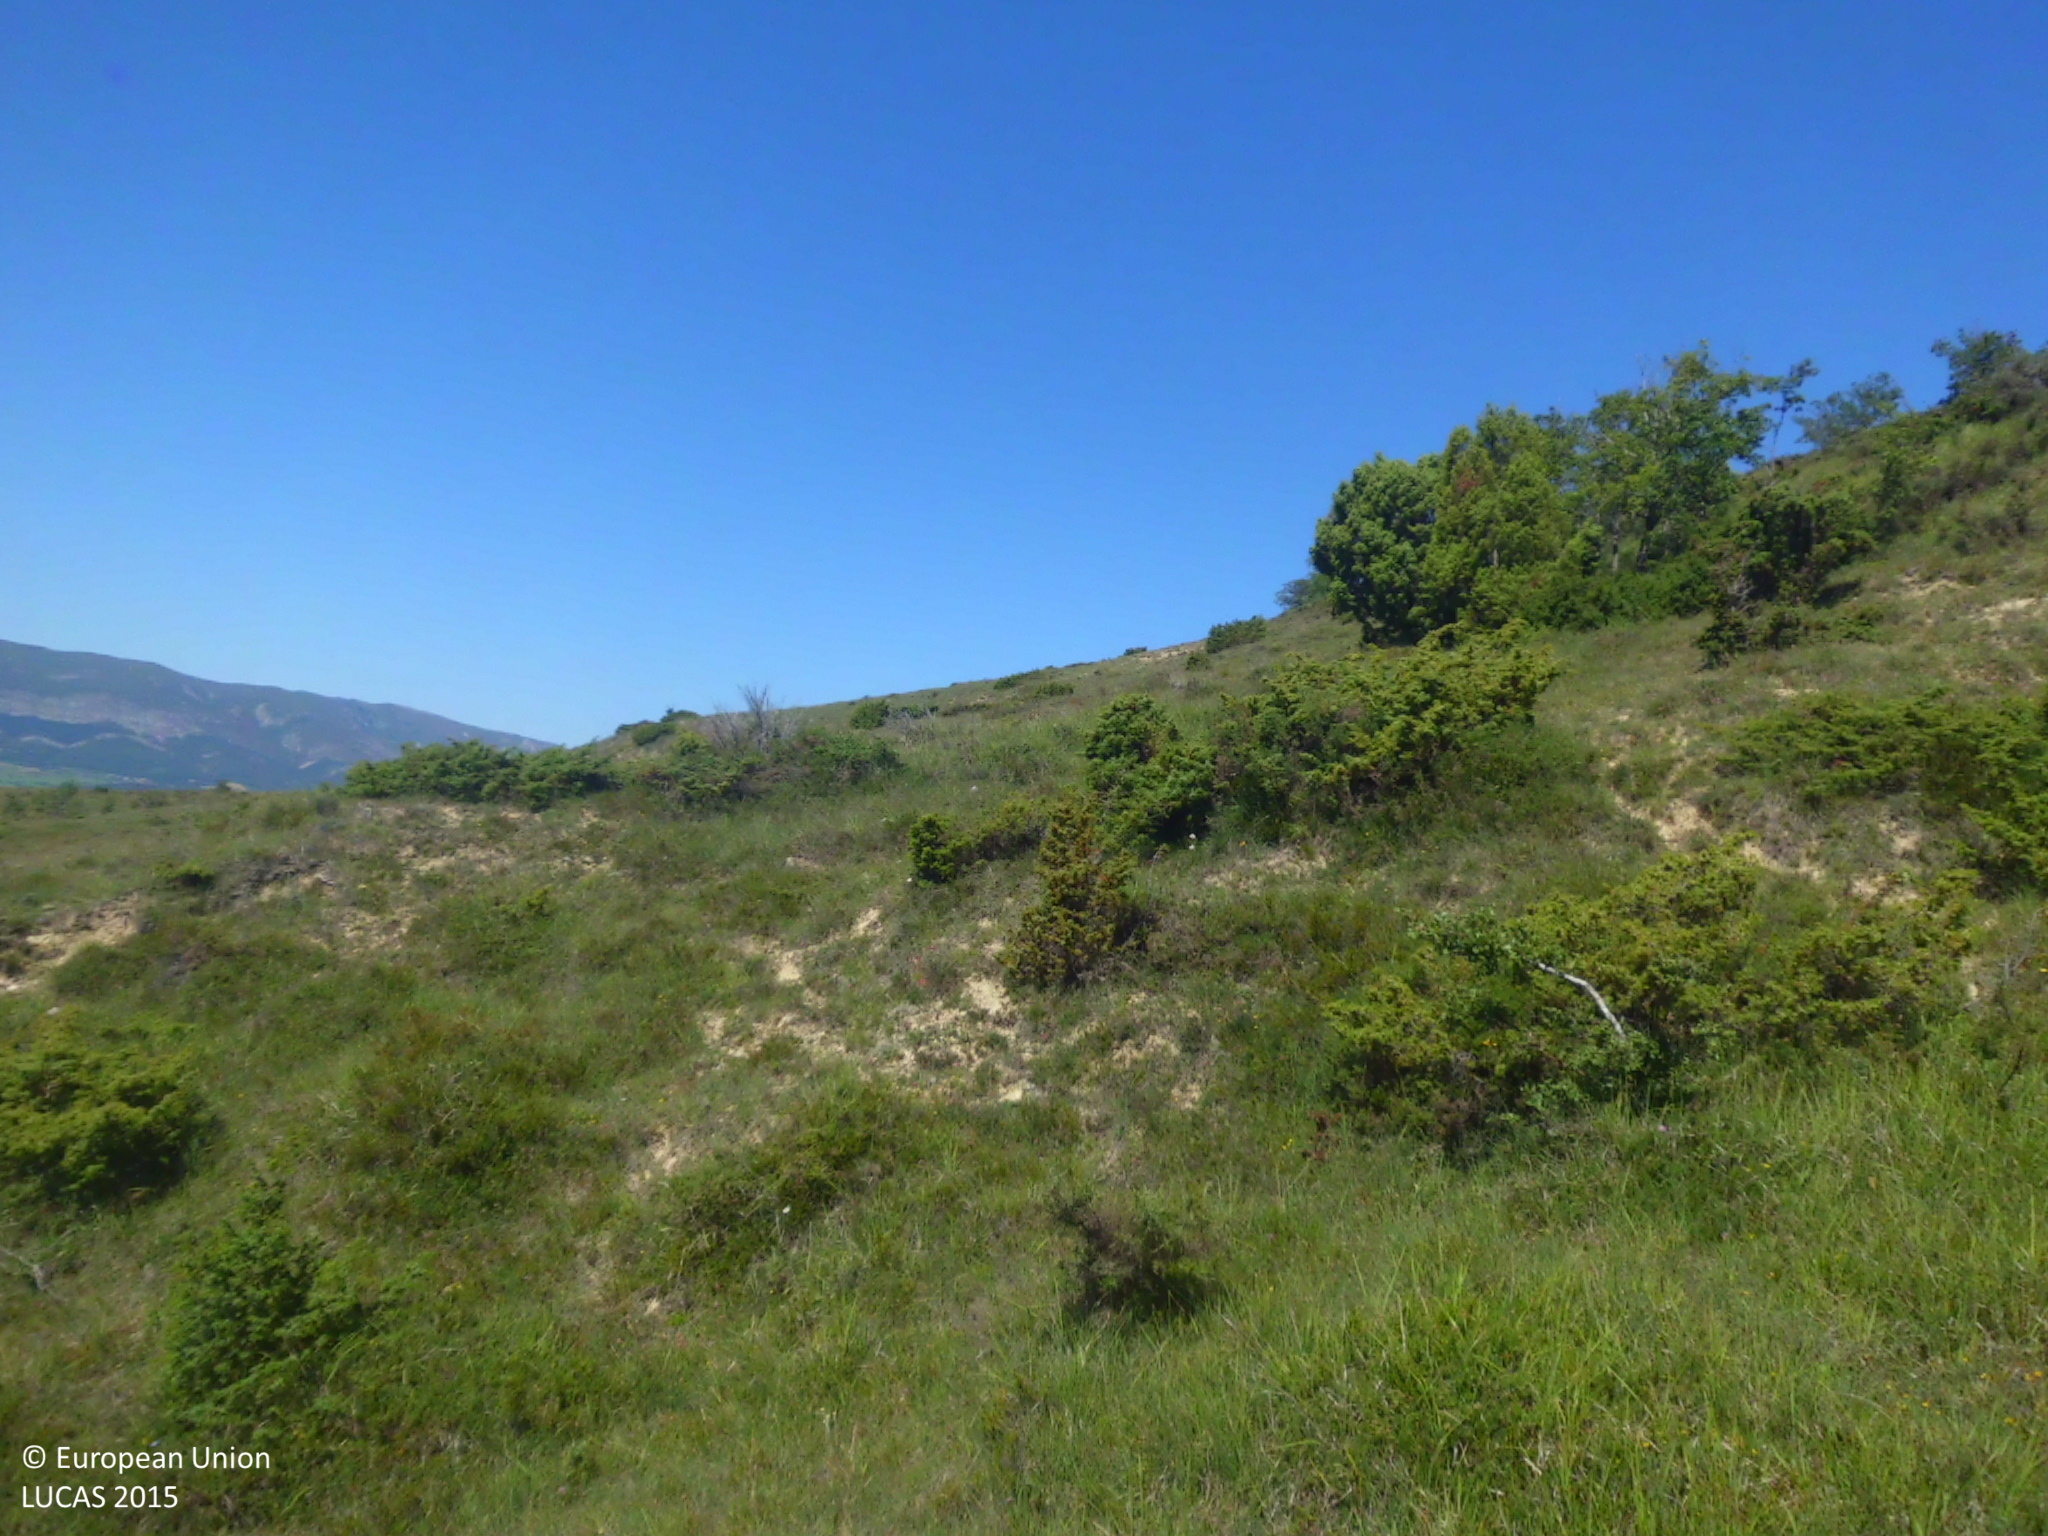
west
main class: Grassland
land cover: Grassland with sparse tree/shrub cover
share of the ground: > 75 %
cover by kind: herbaceous plants 85 %, broadleaved forest trees 5 %, shrubs 5 %, consolidated bare surface 5 %
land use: Agriculture (excluding fallow land and kitchen gardens)
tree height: < 5 m
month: June
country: ES
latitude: 42.9073
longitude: -3.4253
